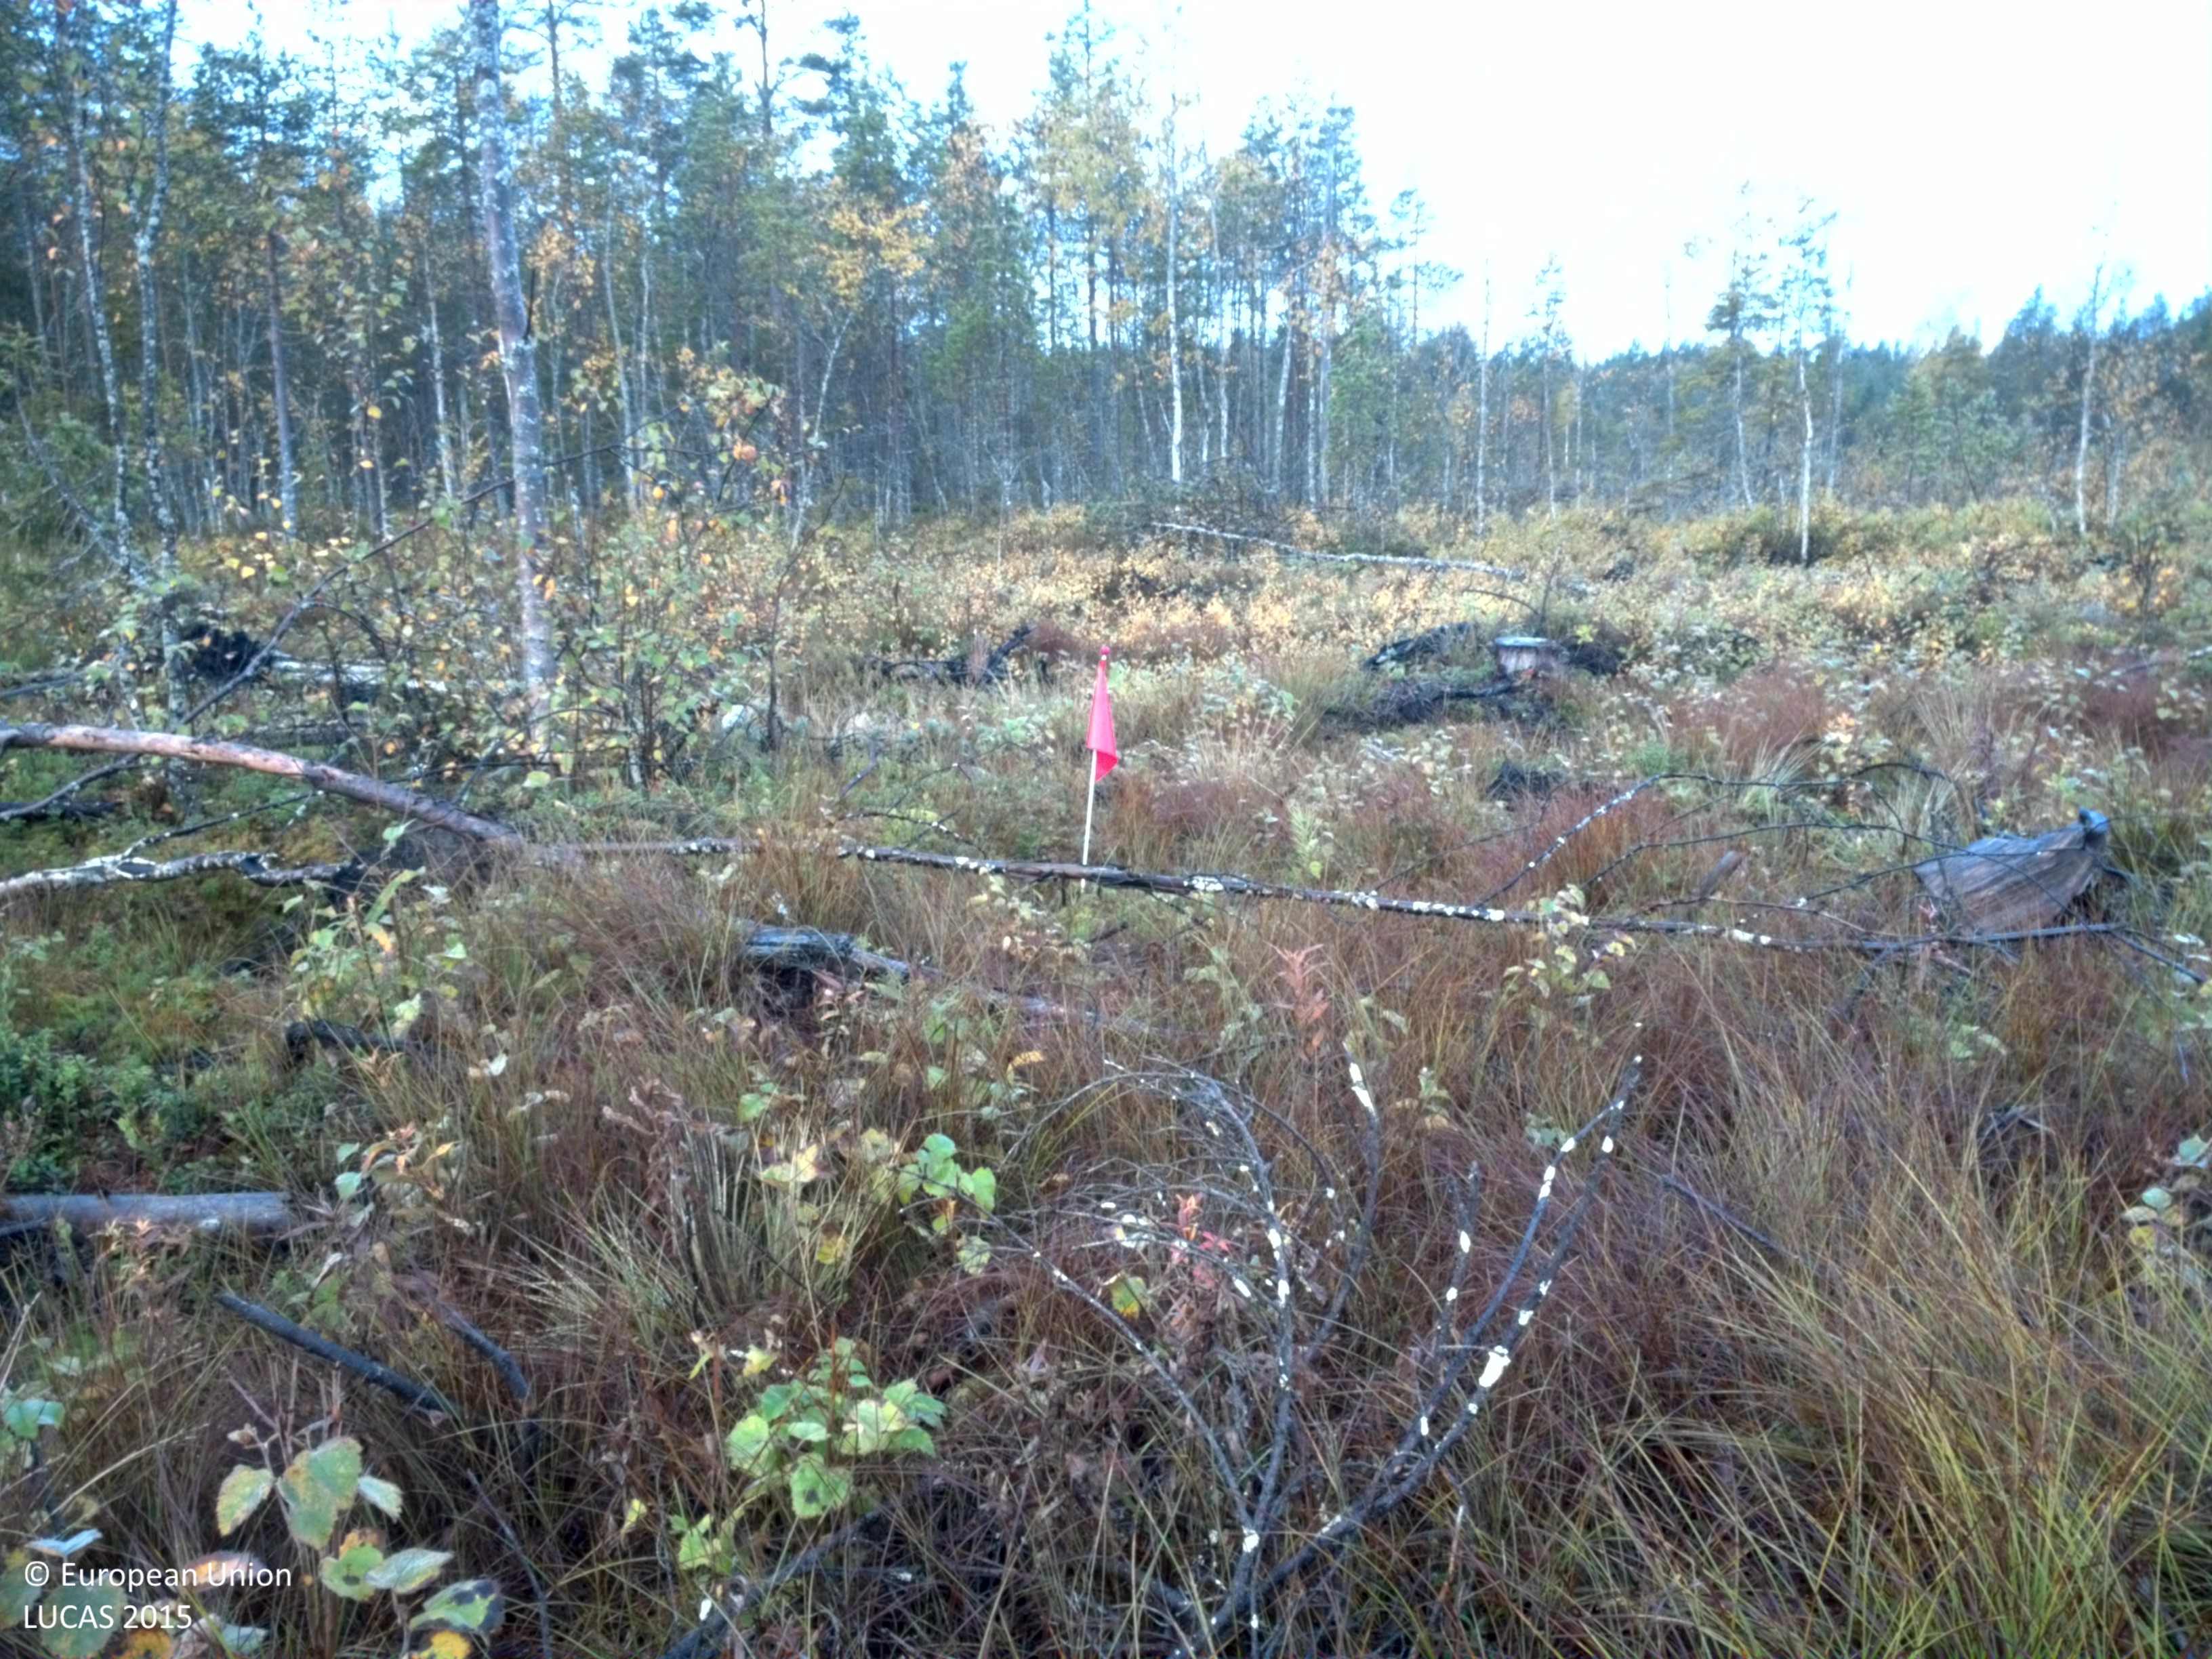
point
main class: Shrubland
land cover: Shrubland with sparse tree cover
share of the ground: 25 - 50 %
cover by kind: herbaceous plants 45 %, shrubs 40 %, lichens and mosses 10 %, broadleaved forest trees 5 %
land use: Forestry
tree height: < 5 m
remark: Clear cut
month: September
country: SE
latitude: 65.5807
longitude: 21.8782
